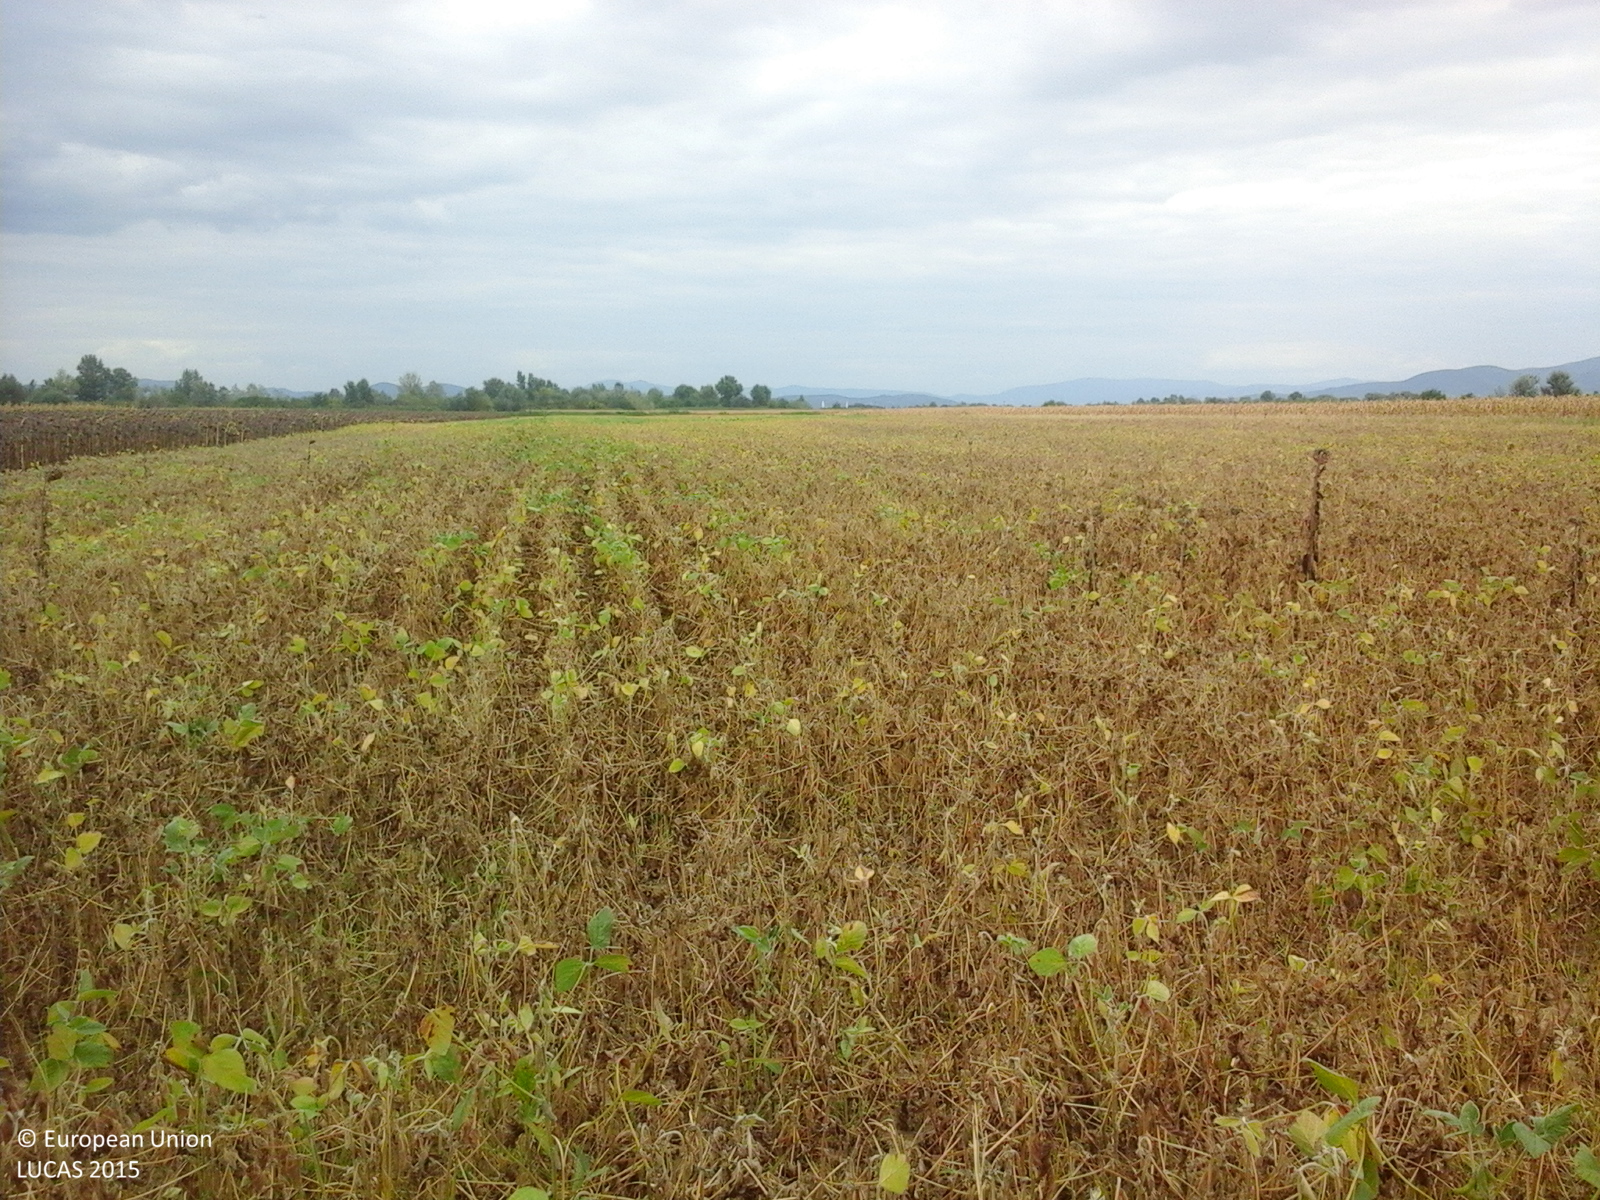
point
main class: Cropland
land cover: Soya
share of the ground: > 75 %
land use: Agriculture (excluding fallow land and kitchen gardens)
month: September
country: RO
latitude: 47.7236
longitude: 23.1473
